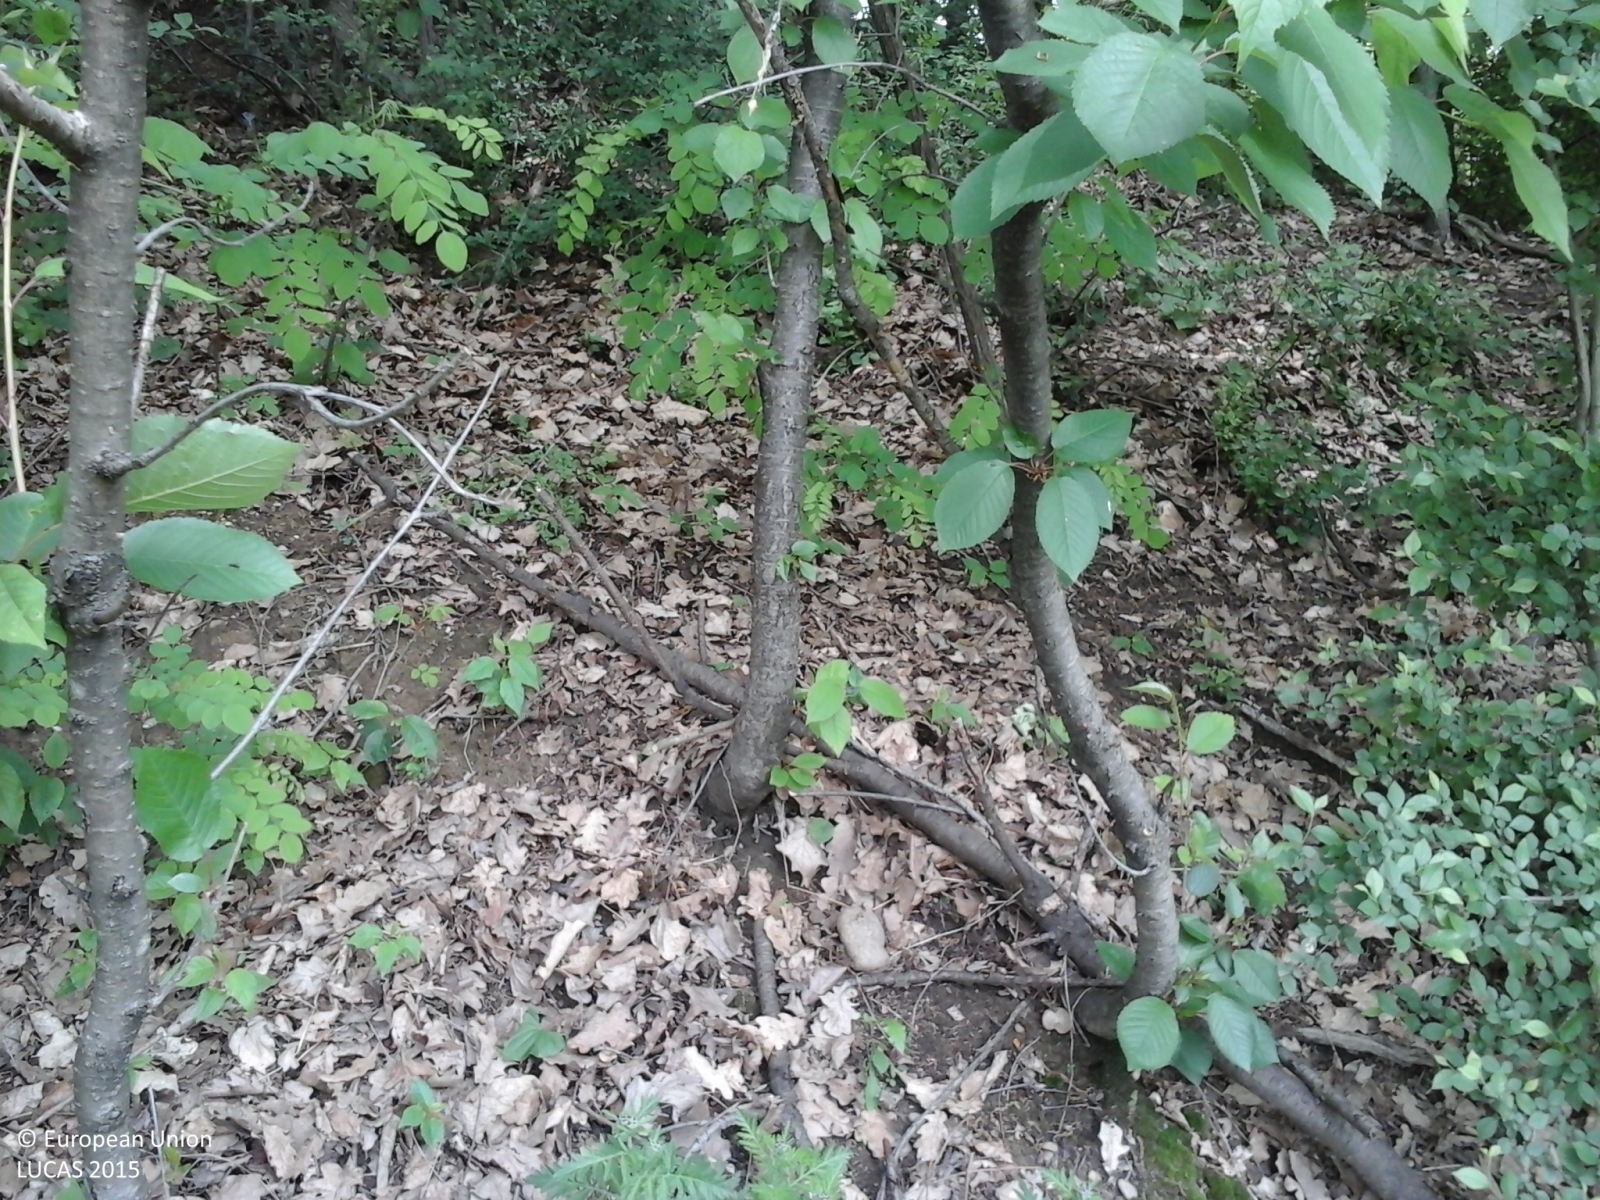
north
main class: Woodland
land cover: Broadleaved woodland
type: thermophilous deciduous forest
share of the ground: > 75 %
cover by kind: broadleaved forest trees 95 %, herbaceous plants 5 %
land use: Forestry
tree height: > 5 m
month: May
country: IT
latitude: 44.5613
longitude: 7.7761
